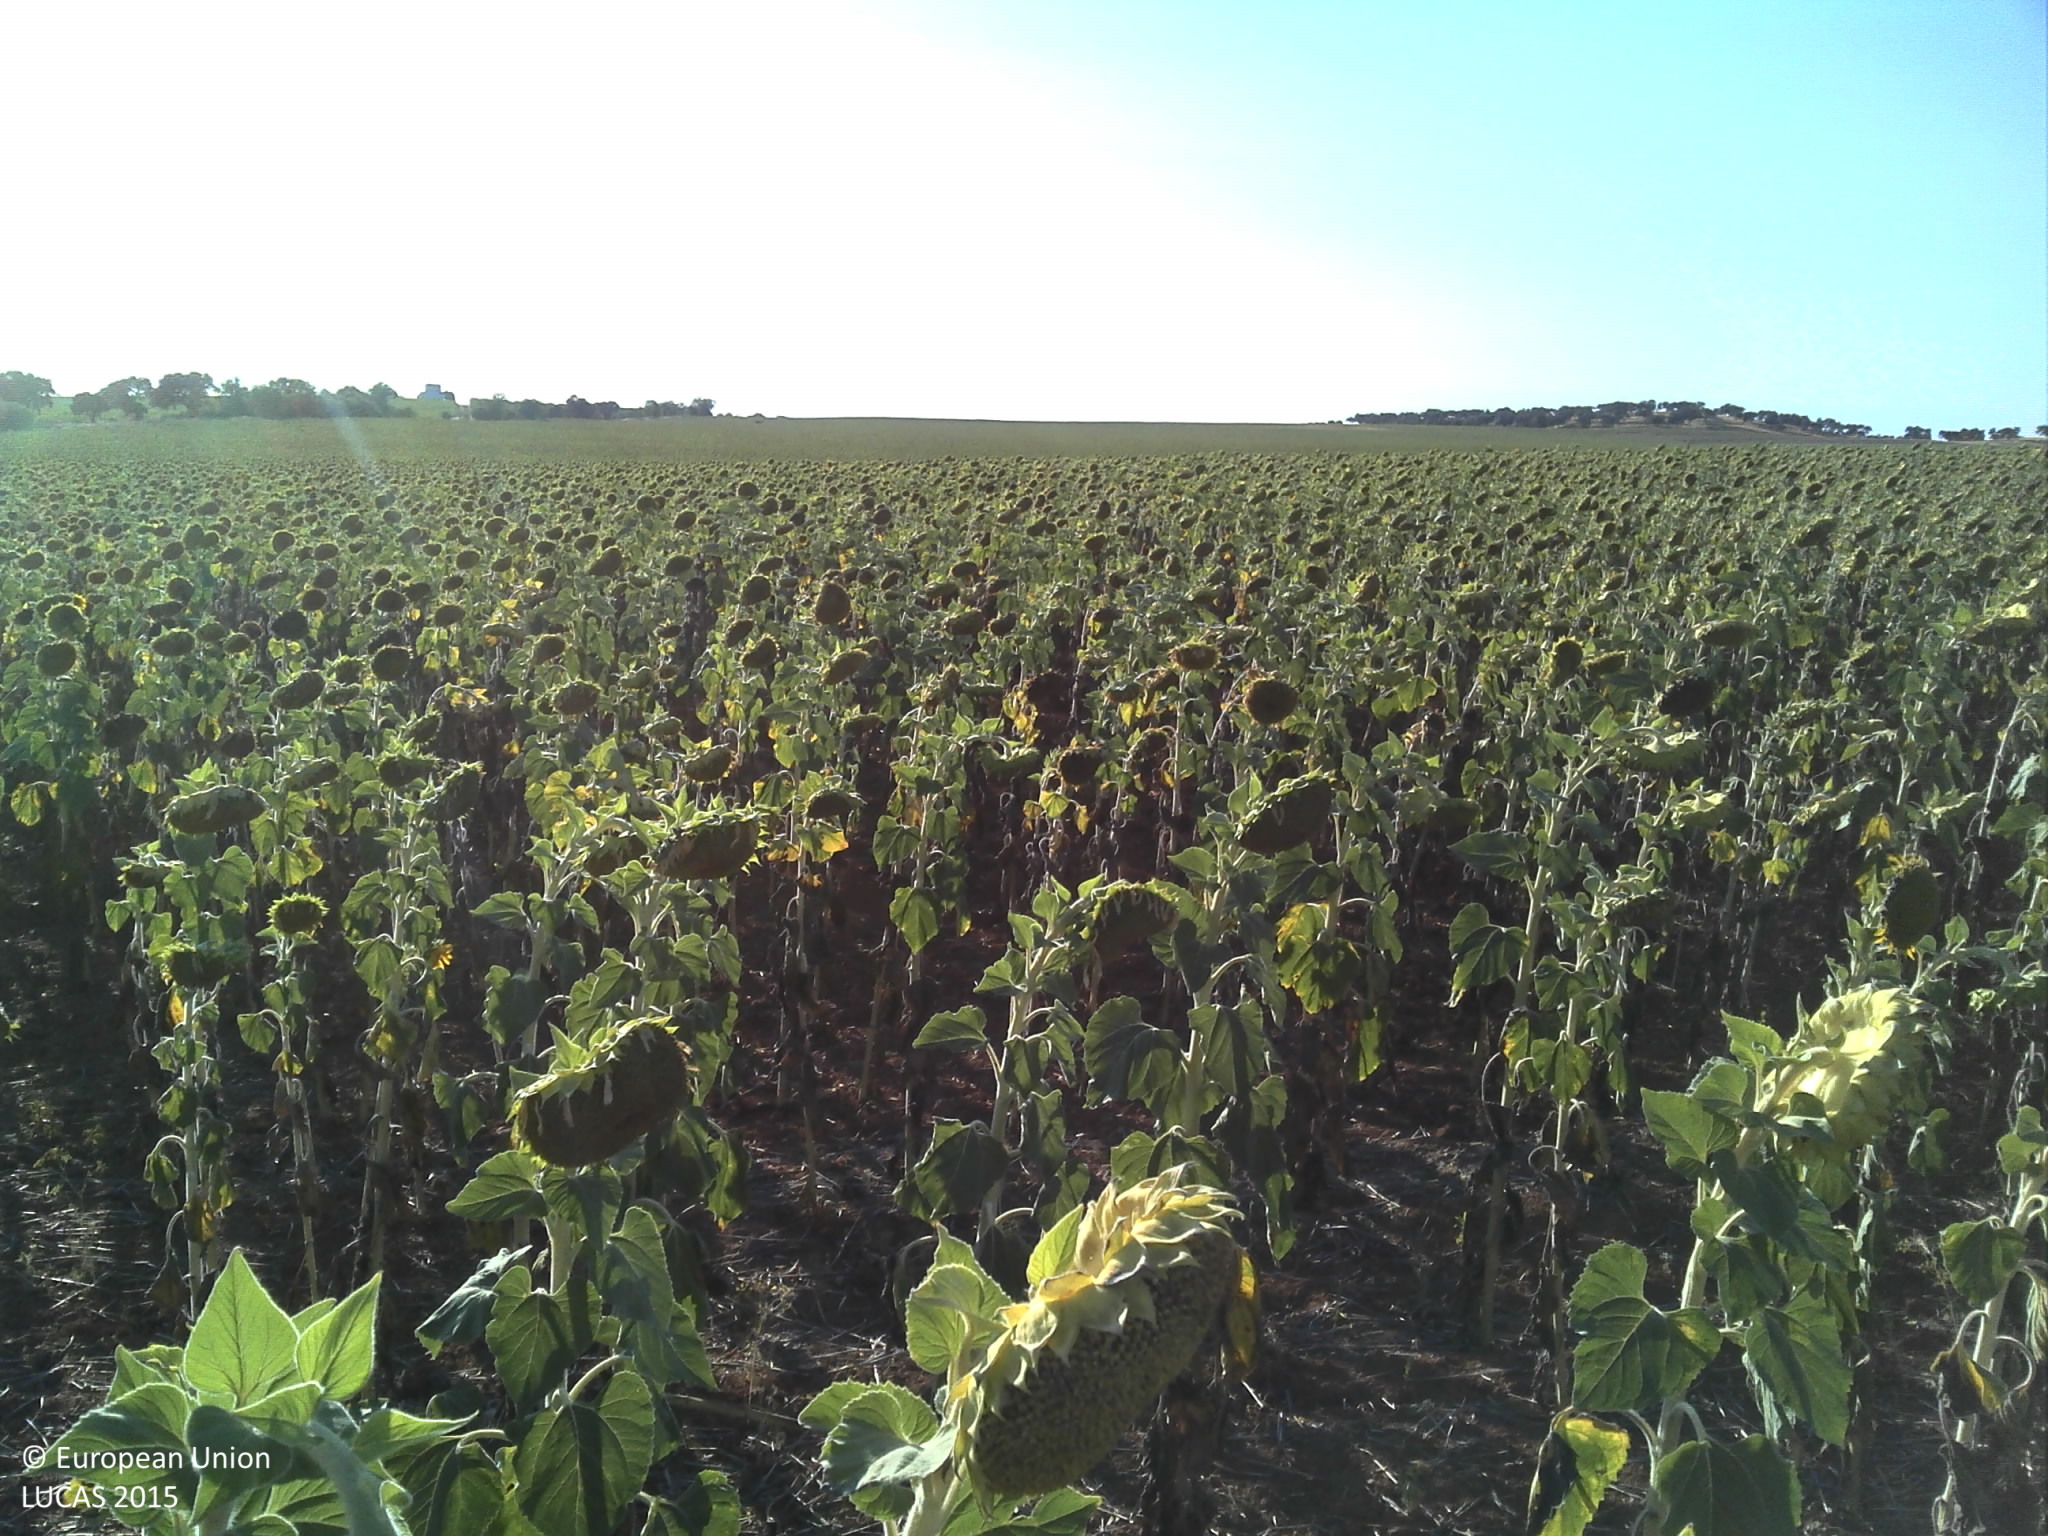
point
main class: Cropland
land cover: Sunflower
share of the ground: > 75 %
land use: Agriculture (excluding fallow land and kitchen gardens)
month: July
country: PT
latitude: 38.0925
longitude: -7.3841
